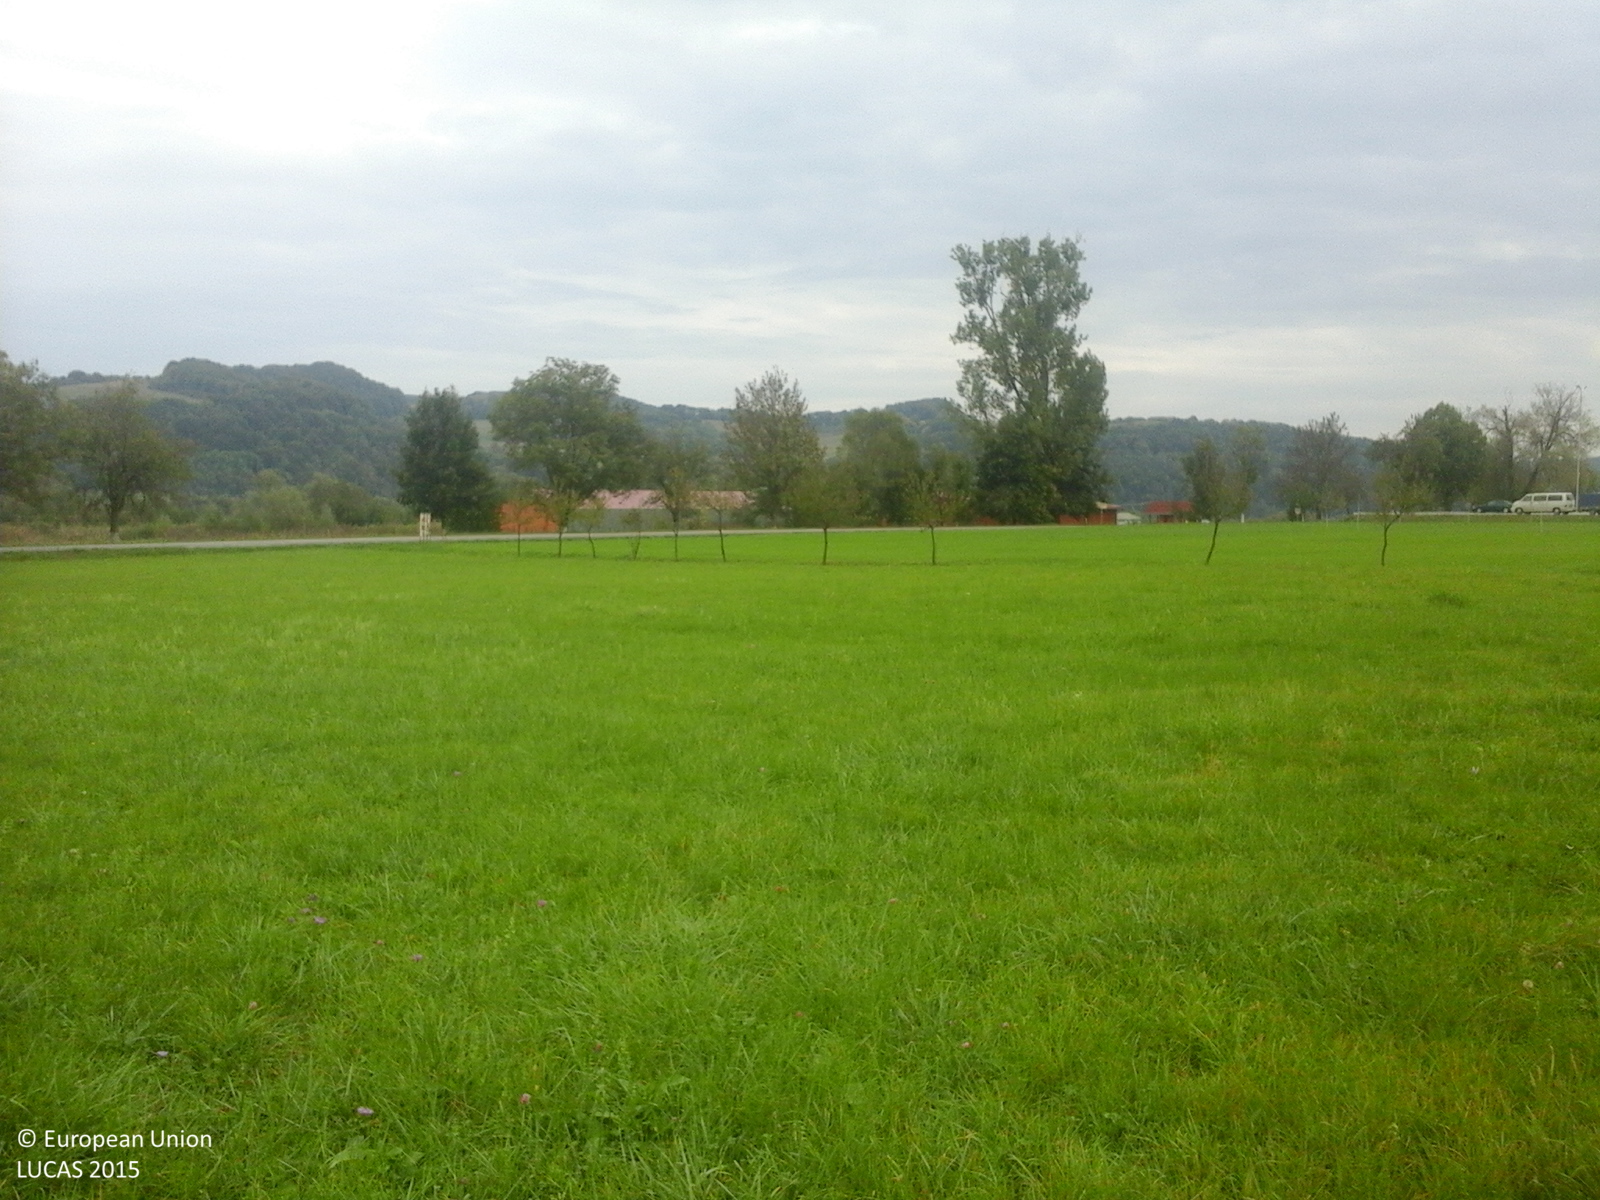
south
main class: Grassland
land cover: Grassland without tree/shrub cover
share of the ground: > 75 %
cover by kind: herbaceous plants 100 %
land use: Agriculture (excluding fallow land and kitchen gardens)
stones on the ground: < 10 %
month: October
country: RO
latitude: 46.5205
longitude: 24.9433
